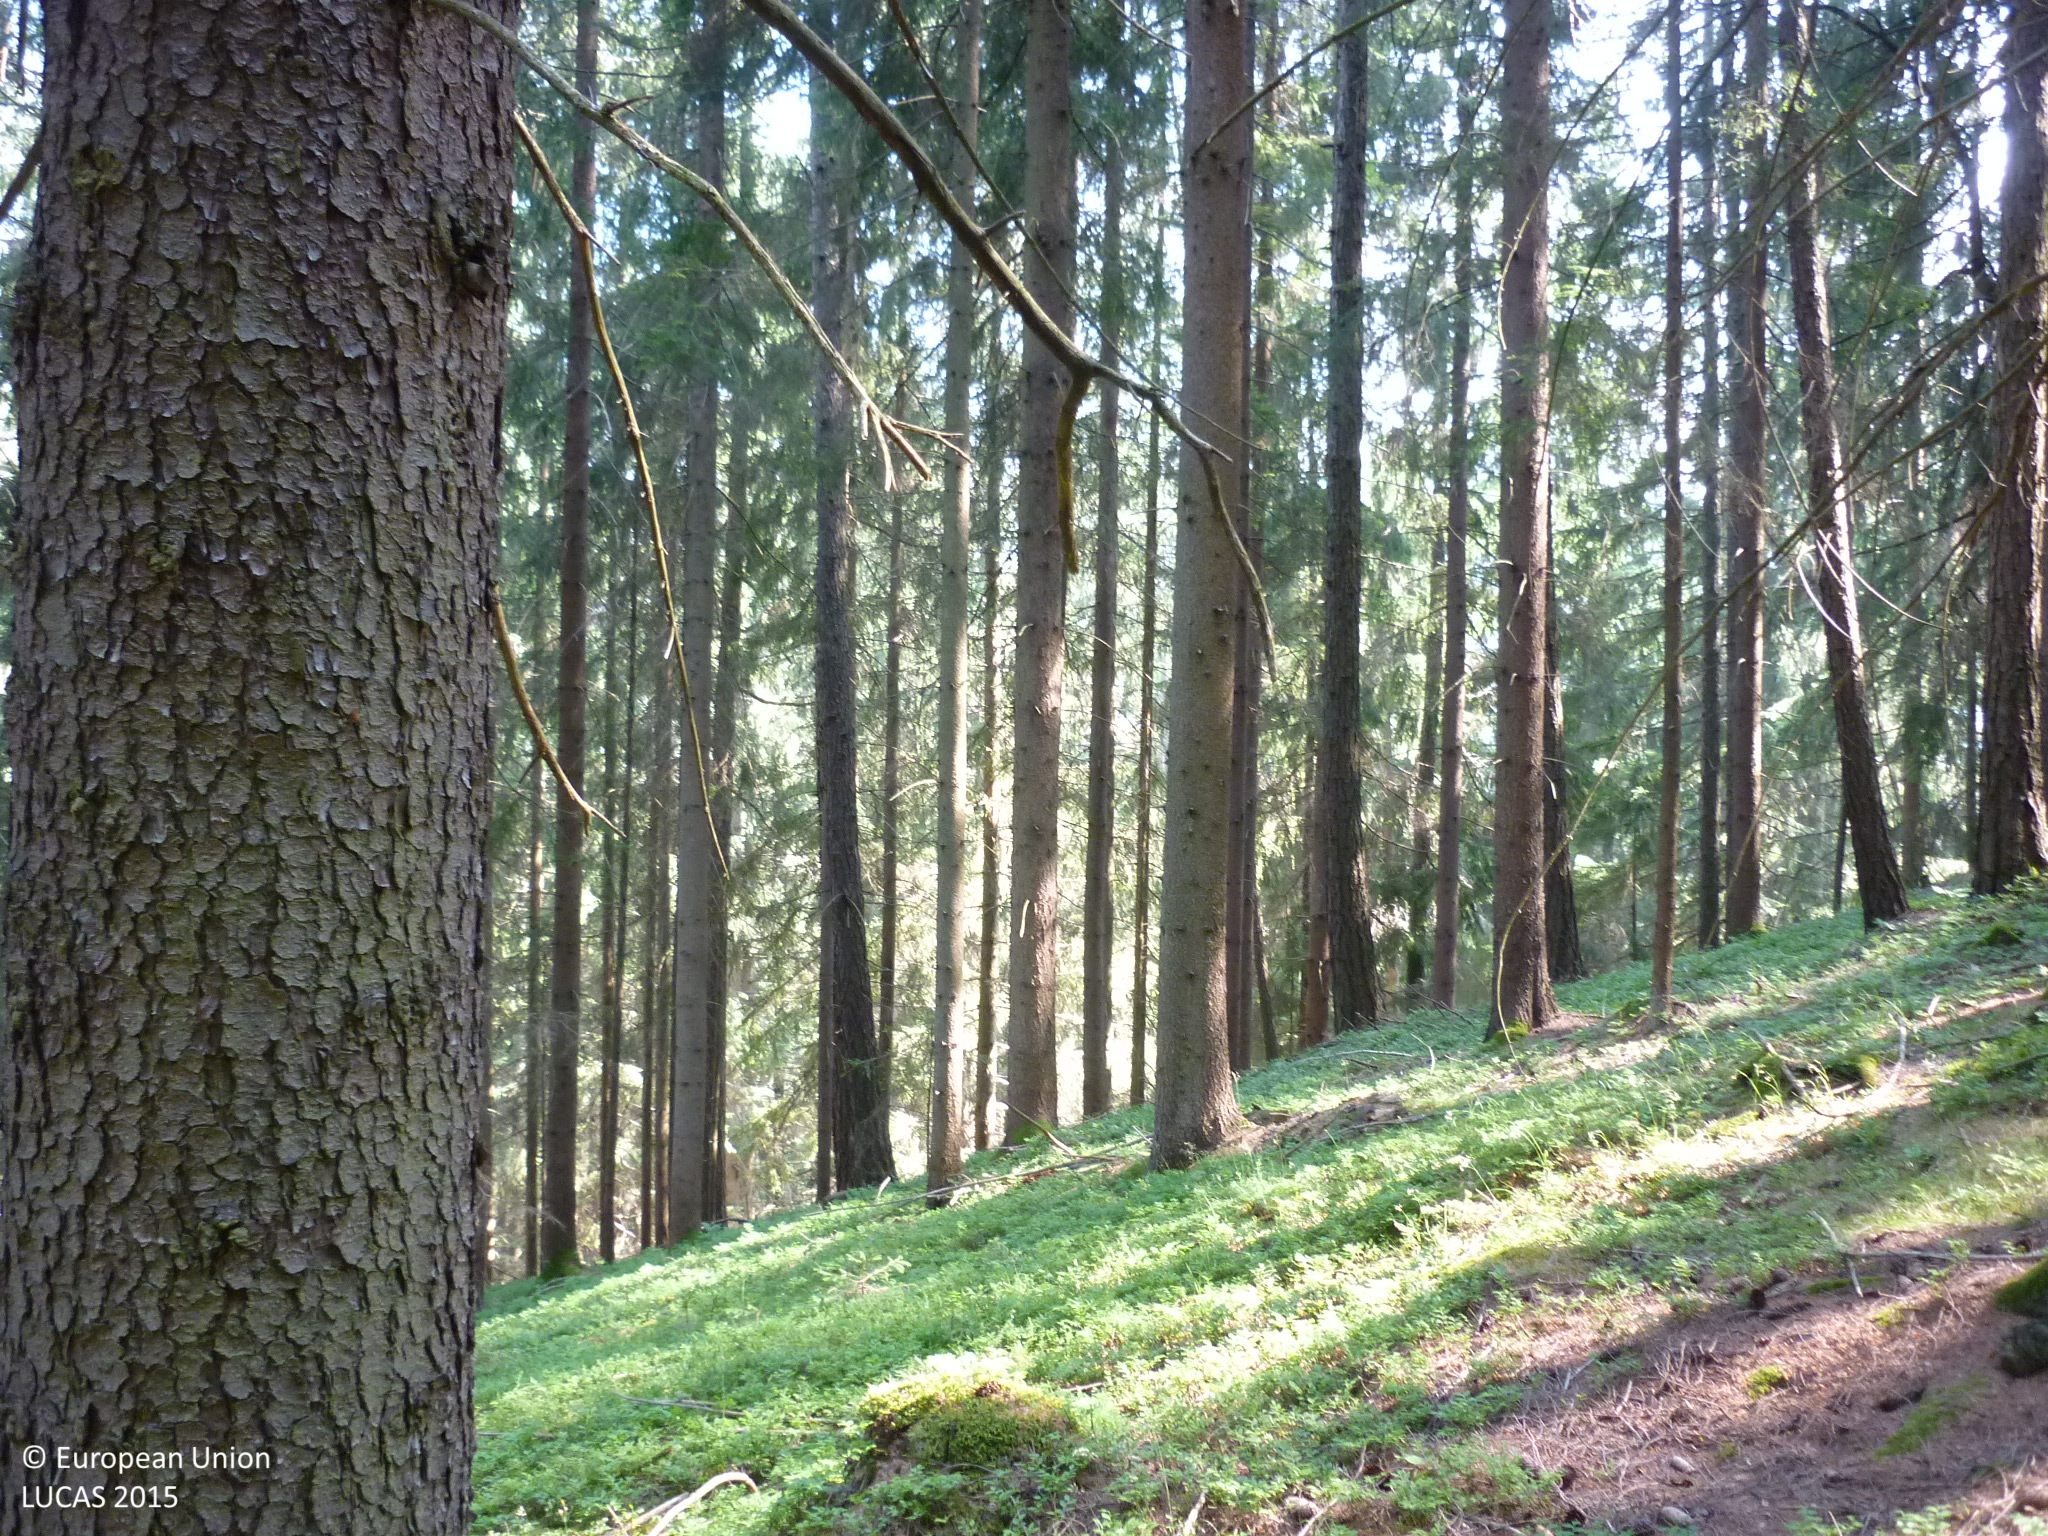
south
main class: Woodland
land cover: Spruce dominated coniferous woodland
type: alpine coniferous forest
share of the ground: > 75 %
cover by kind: coniferous forest trees 95 %, shrubs 5 %
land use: Forestry
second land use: Amenities, museums, leisure
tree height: > 5 m
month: July
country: AT
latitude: 47.0226
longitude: 14.7218
